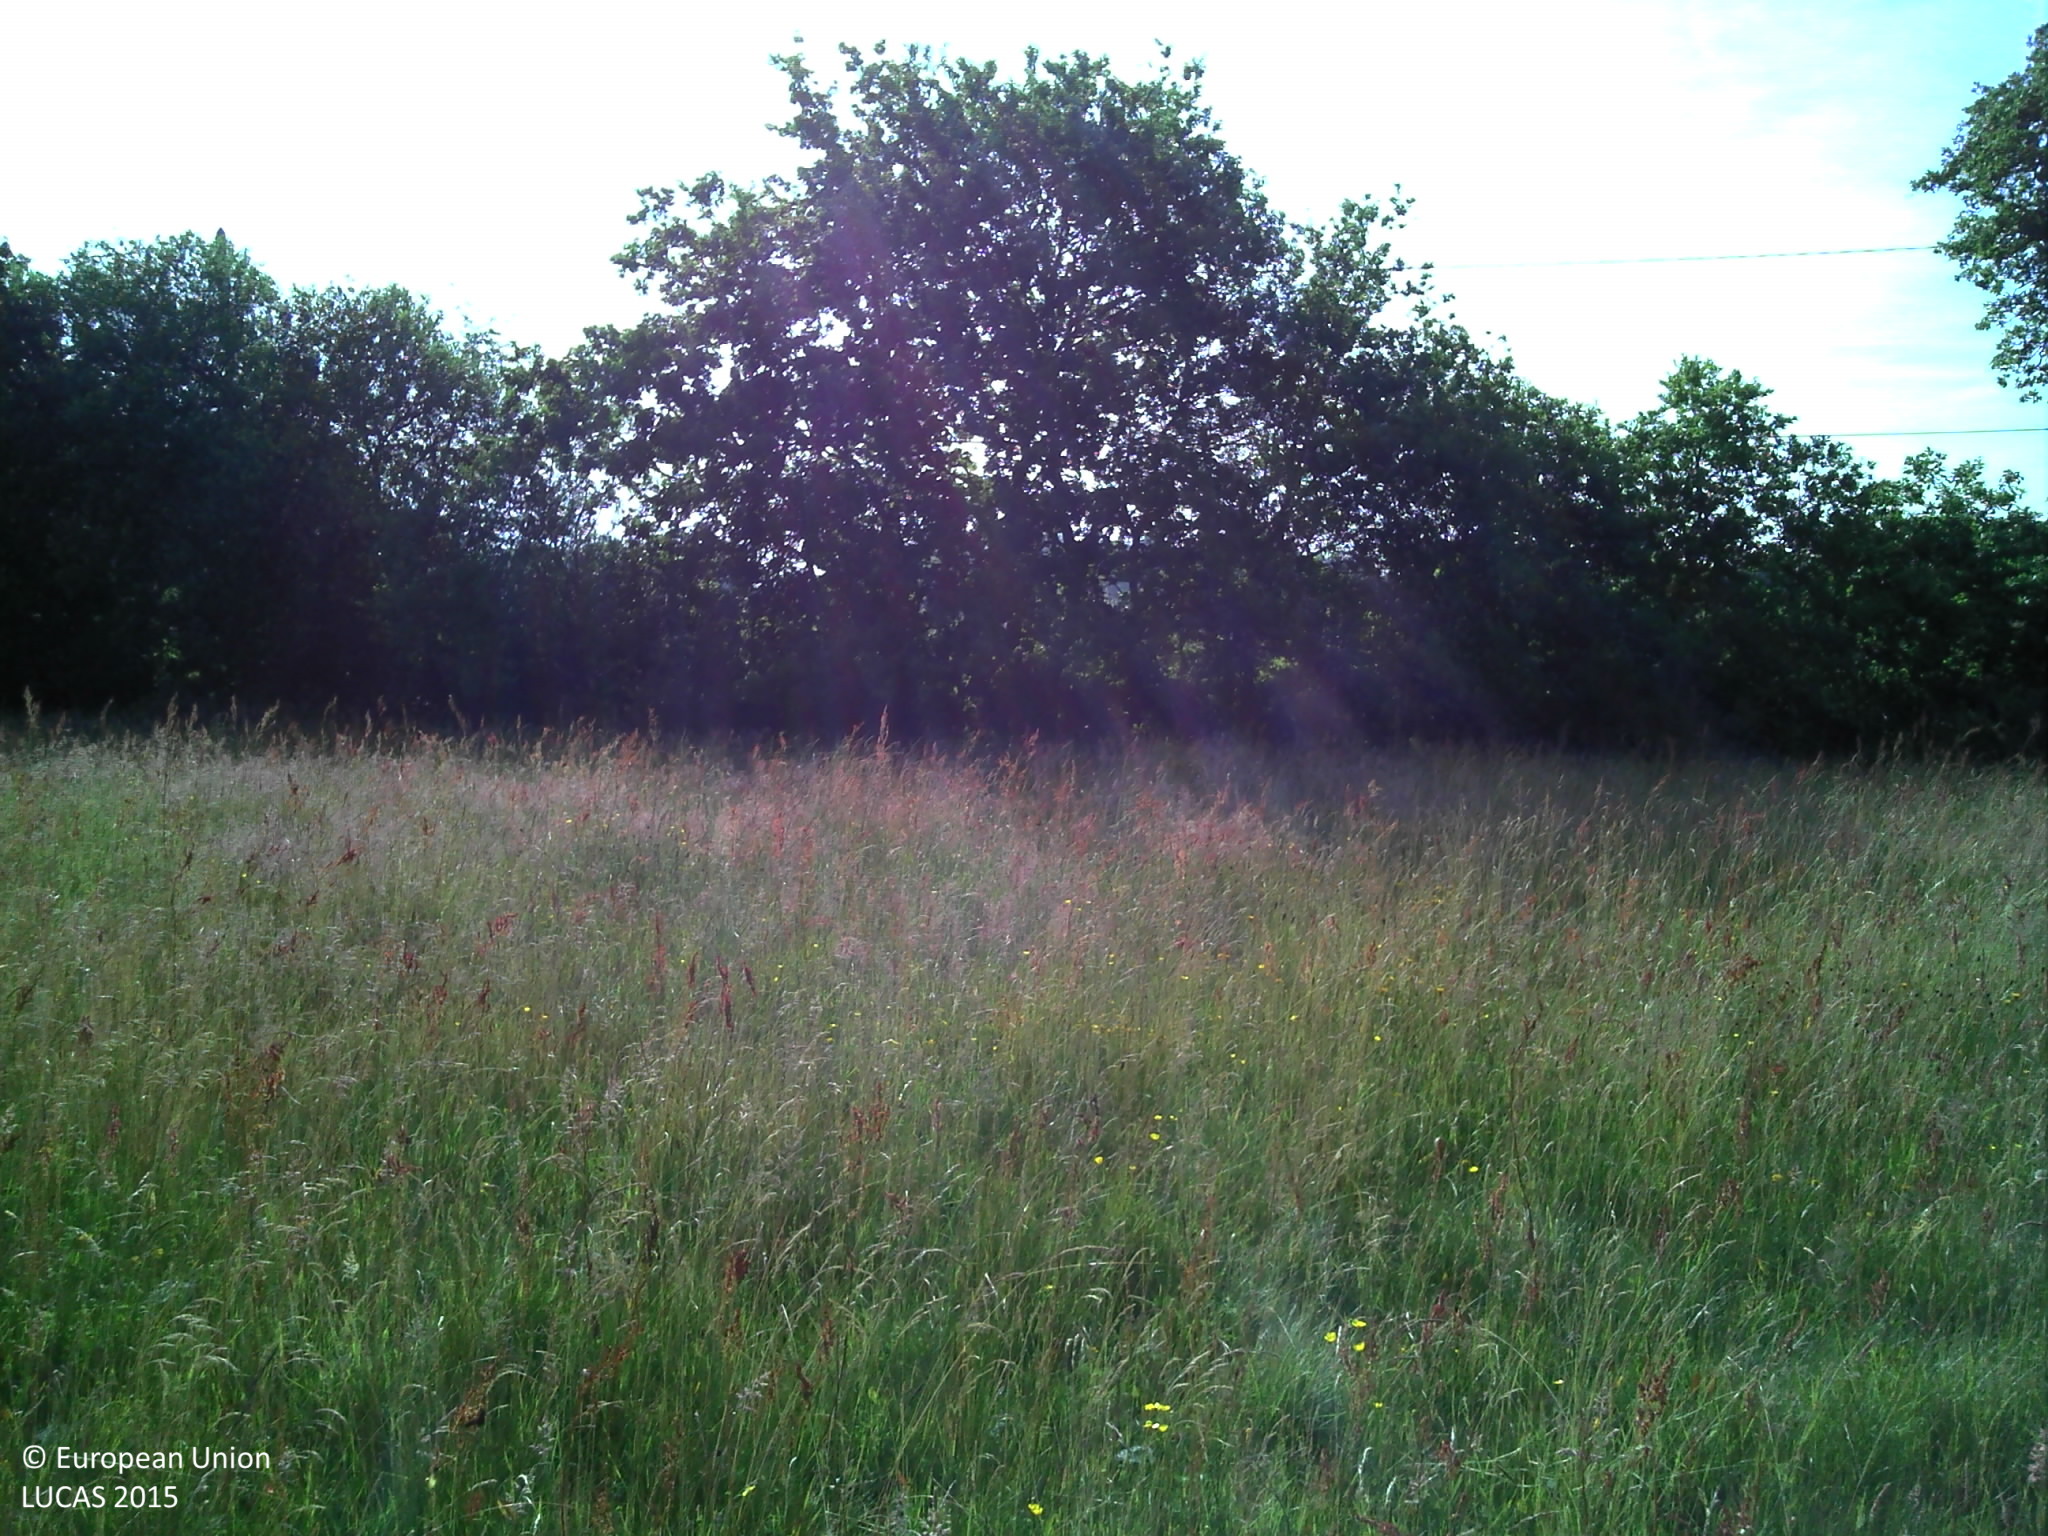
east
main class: Grassland
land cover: Grassland without tree/shrub cover
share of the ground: > 75 %
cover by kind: herbaceous plants 100 %
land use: Agriculture (excluding fallow land and kitchen gardens)
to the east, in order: Grassland without tree/shrub cover; Abandoned hedges; Electric lines; Ditches and canals; Grass margins; Paved roads, cycling and walking lanes; Grass margins; Electric lines; Abandoned hedges; Grassland without tree/shrub cover; Rivers and streams; Broadleaved woodland; Spontaneously vegetated surfaces
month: June
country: FR
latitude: 49.2052
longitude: -1.4541
